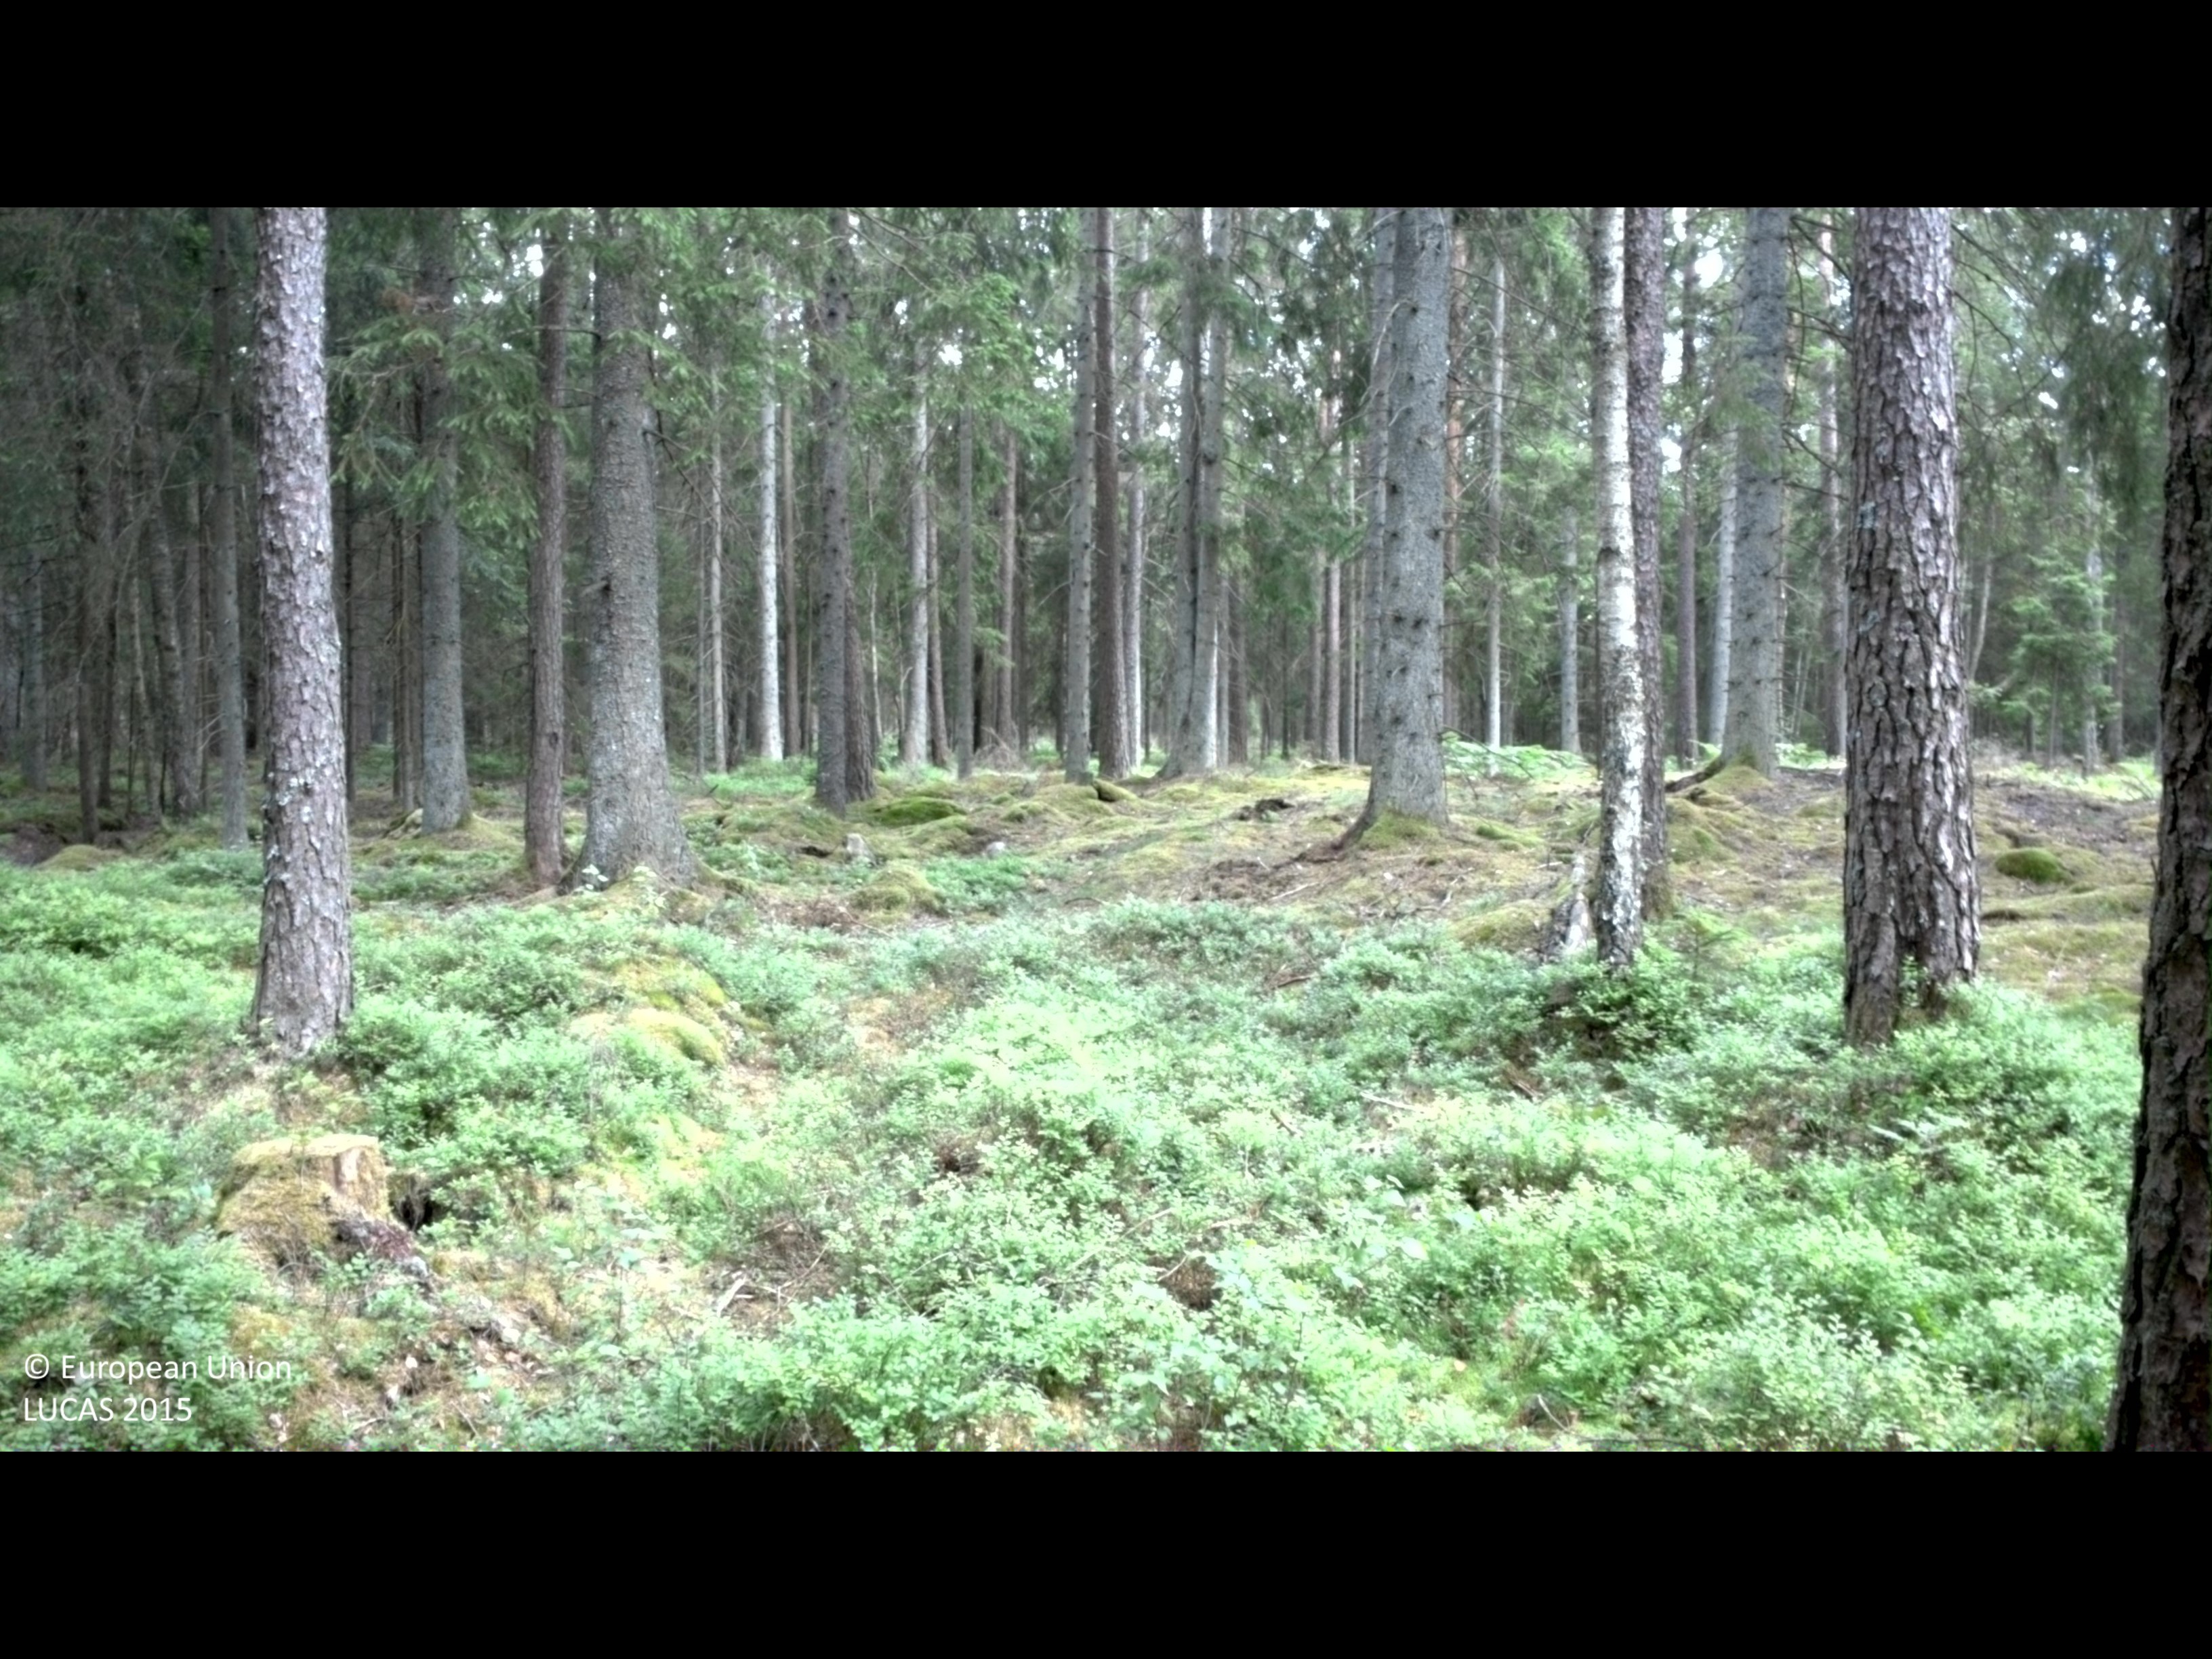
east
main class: Woodland
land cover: Spruce dominated coniferous woodland
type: boreal forest
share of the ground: 50 - 75 %
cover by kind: coniferous forest trees 65 %, shrubs 30 %, lichens and mosses 5 %
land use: Forestry
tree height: > 5 m
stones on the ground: < 10 %
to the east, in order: Spruce dominated coniferous woodland; Shruby margins; Paved roads, cycling and walking lanes; Shruby margins; Spruce dominated coniferous woodland
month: July
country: SE
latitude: 56.4930
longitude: 13.7490
